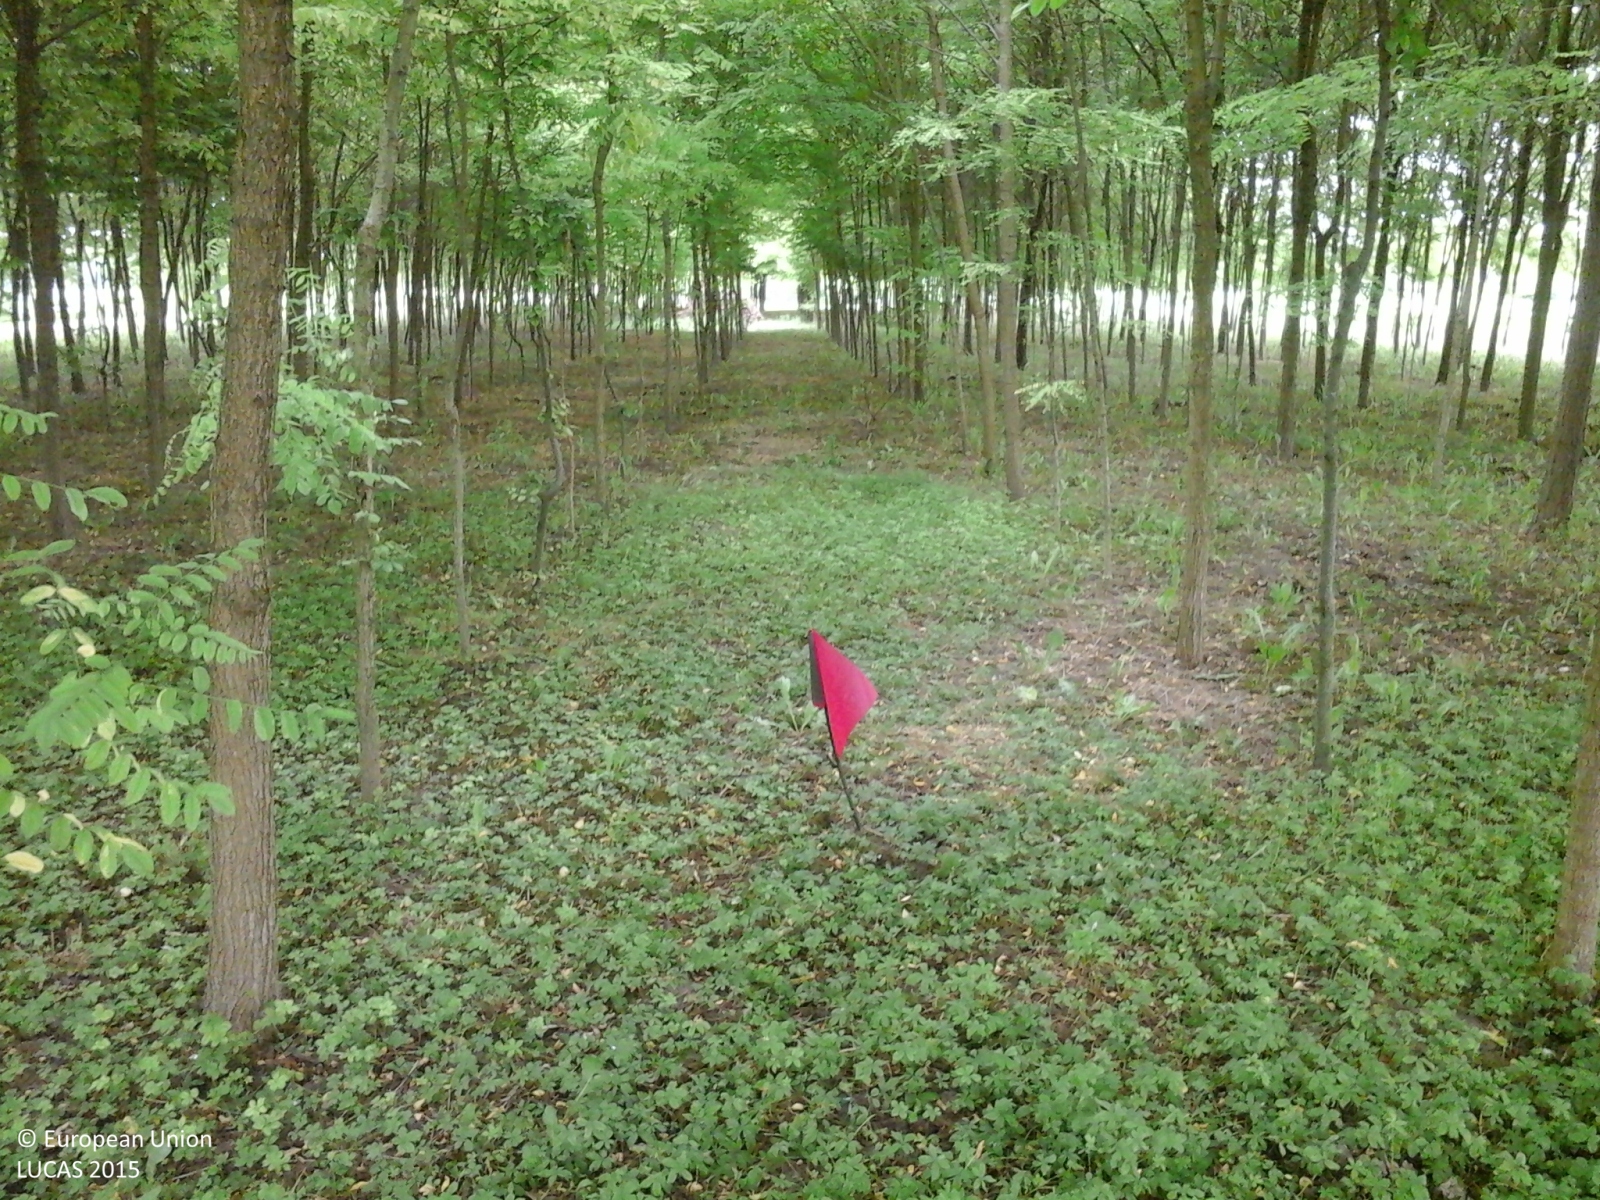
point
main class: Woodland
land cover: Broadleaved woodland
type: thermophilous deciduous forest
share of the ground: > 75 %
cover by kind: broadleaved forest trees 100 %
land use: Forestry
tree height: > 5 m
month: June
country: IT
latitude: 45.6881
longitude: 12.6286
